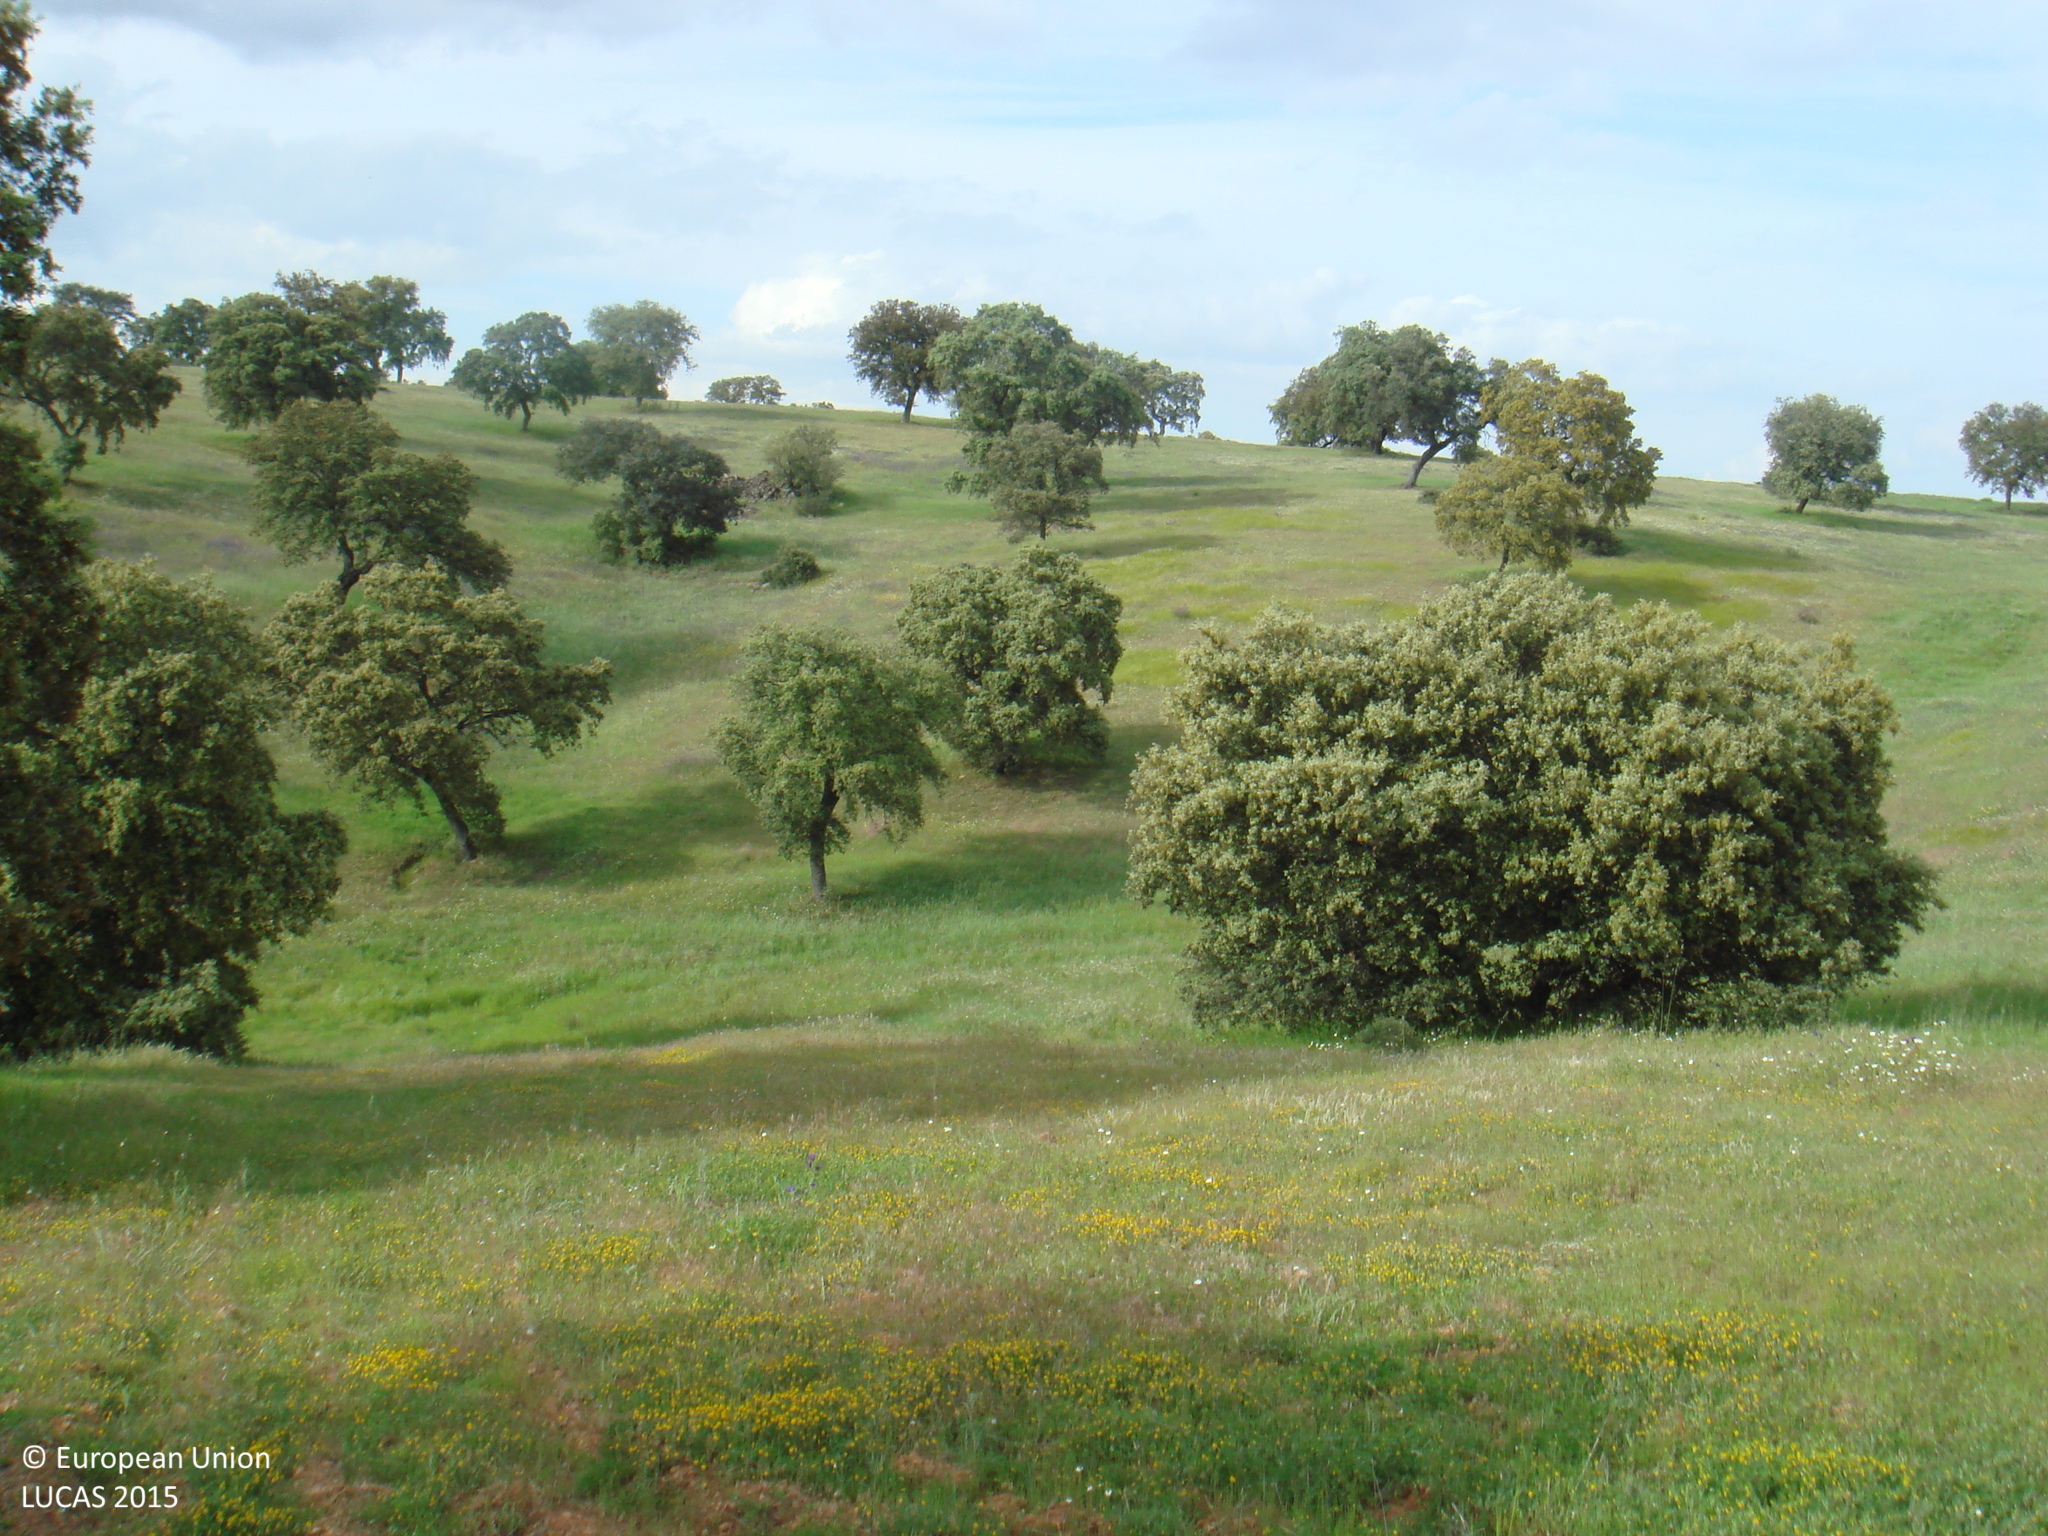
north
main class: Grassland
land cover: Grassland with sparse tree/shrub cover
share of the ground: > 75 %
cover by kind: herbaceous plants 50 %, unconsolidated bare surface 45 %, broadleaved forest trees 5 %
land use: Agriculture (excluding fallow land and kitchen gardens)
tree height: > 5 m
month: April
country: ES
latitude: 38.1894
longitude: -4.9907
